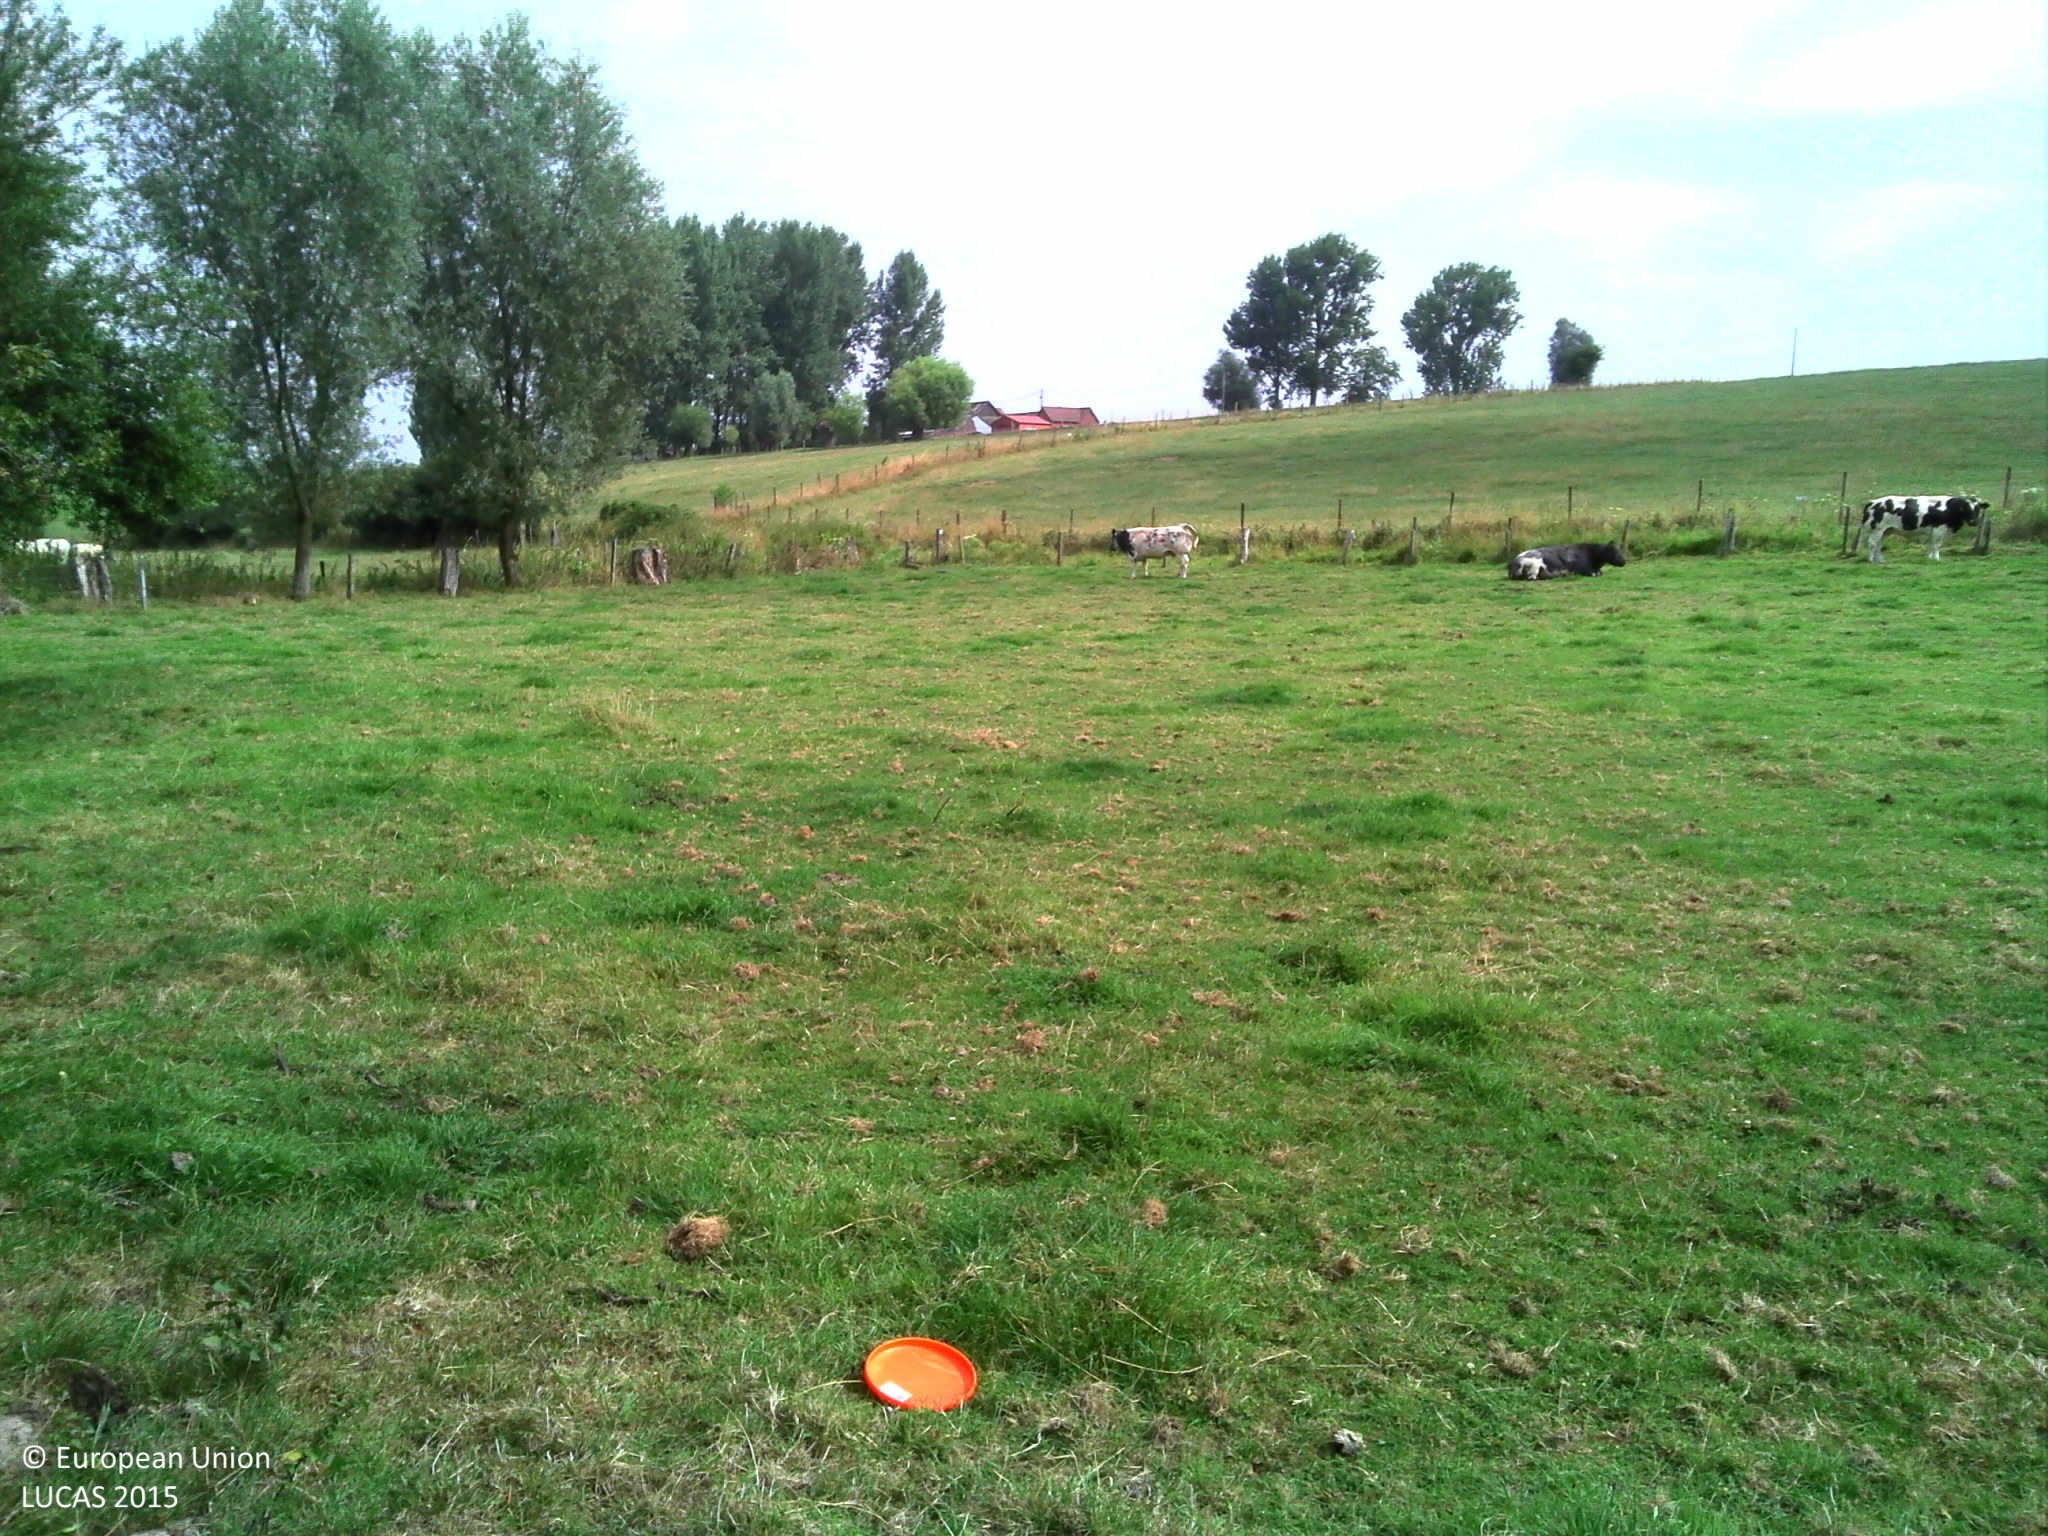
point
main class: Grassland
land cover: Grassland without tree/shrub cover
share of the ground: > 75 %
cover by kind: herbaceous plants 100 %
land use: Agriculture (excluding fallow land and kitchen gardens)
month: August
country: BE
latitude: 50.6817
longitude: 3.7803
